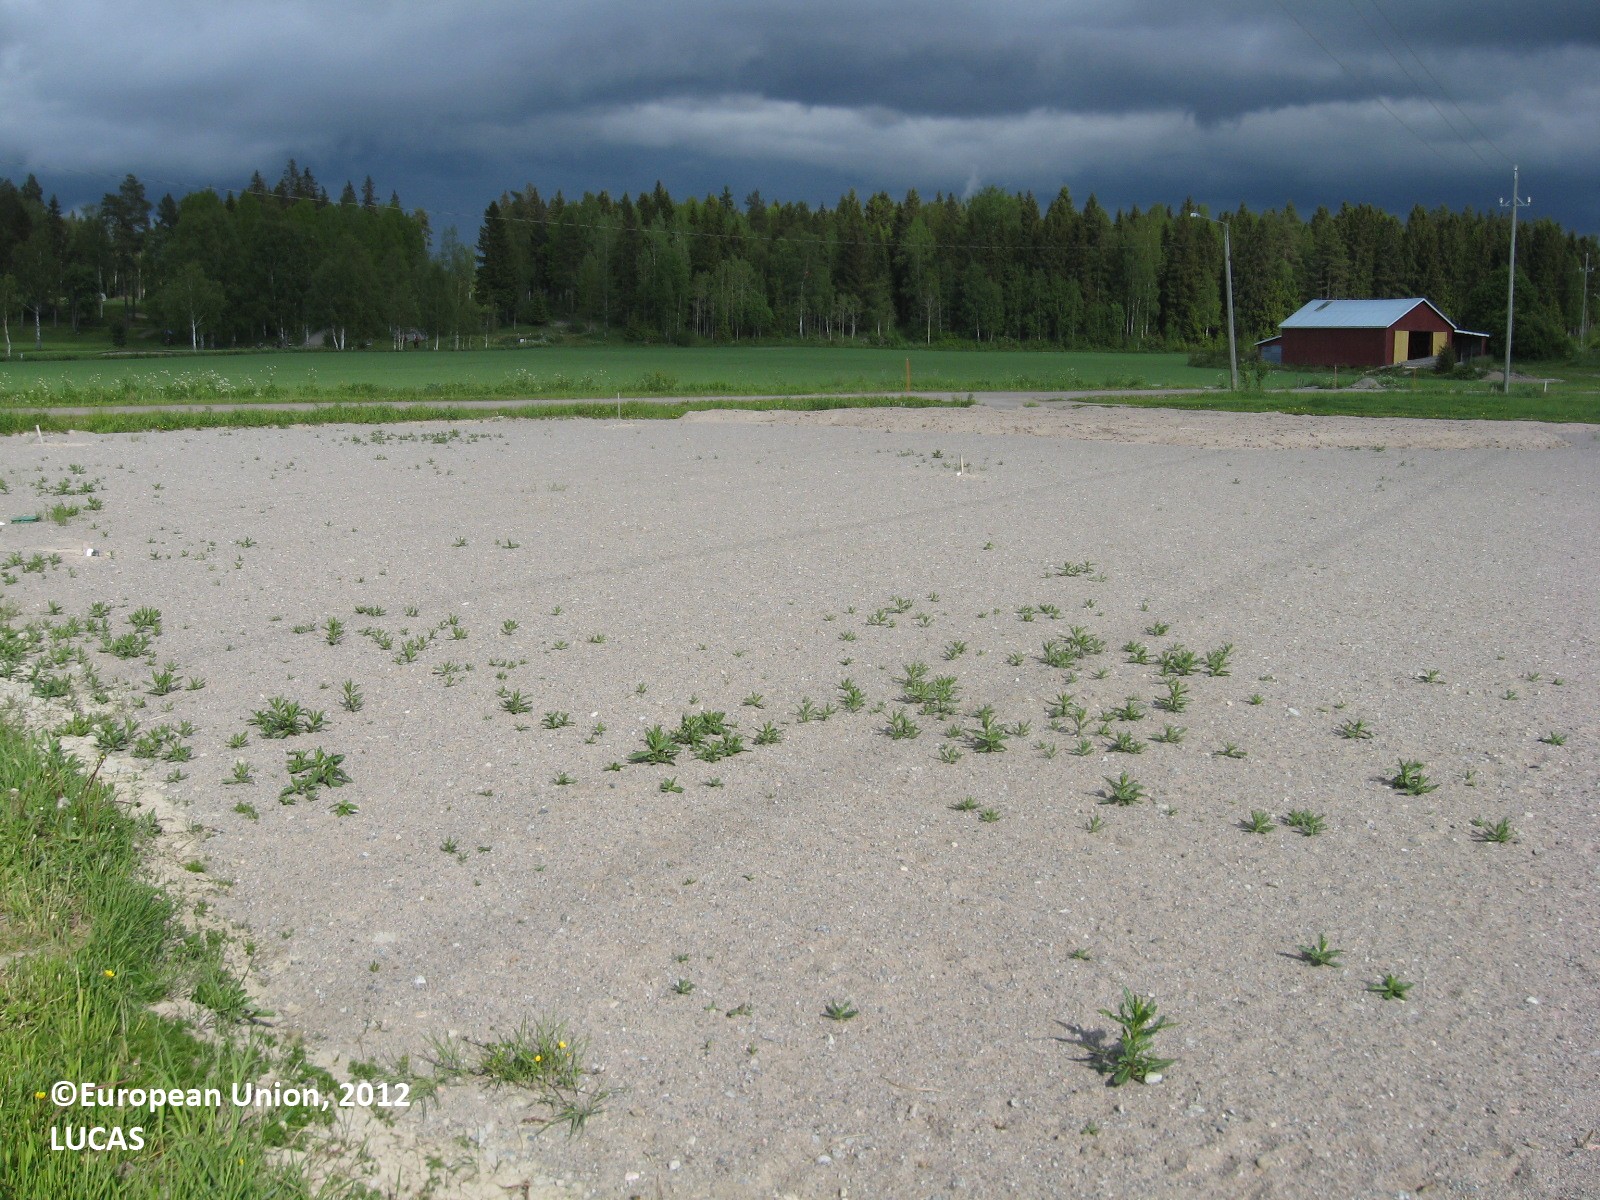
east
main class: Grassland
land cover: Grassland without tree/shrub cover
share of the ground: > 75 %
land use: Agriculture (excluding fallow land and kitchen gardens)
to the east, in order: Grassland without tree/shrub cover; Other bare soil; Grass margins; Ditches and canals; Grass margins; Paved roads, cycling and walking lanes; Grass margins; Ditches and canals; Barley
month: June
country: FI
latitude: 63.0830
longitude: 21.7432
